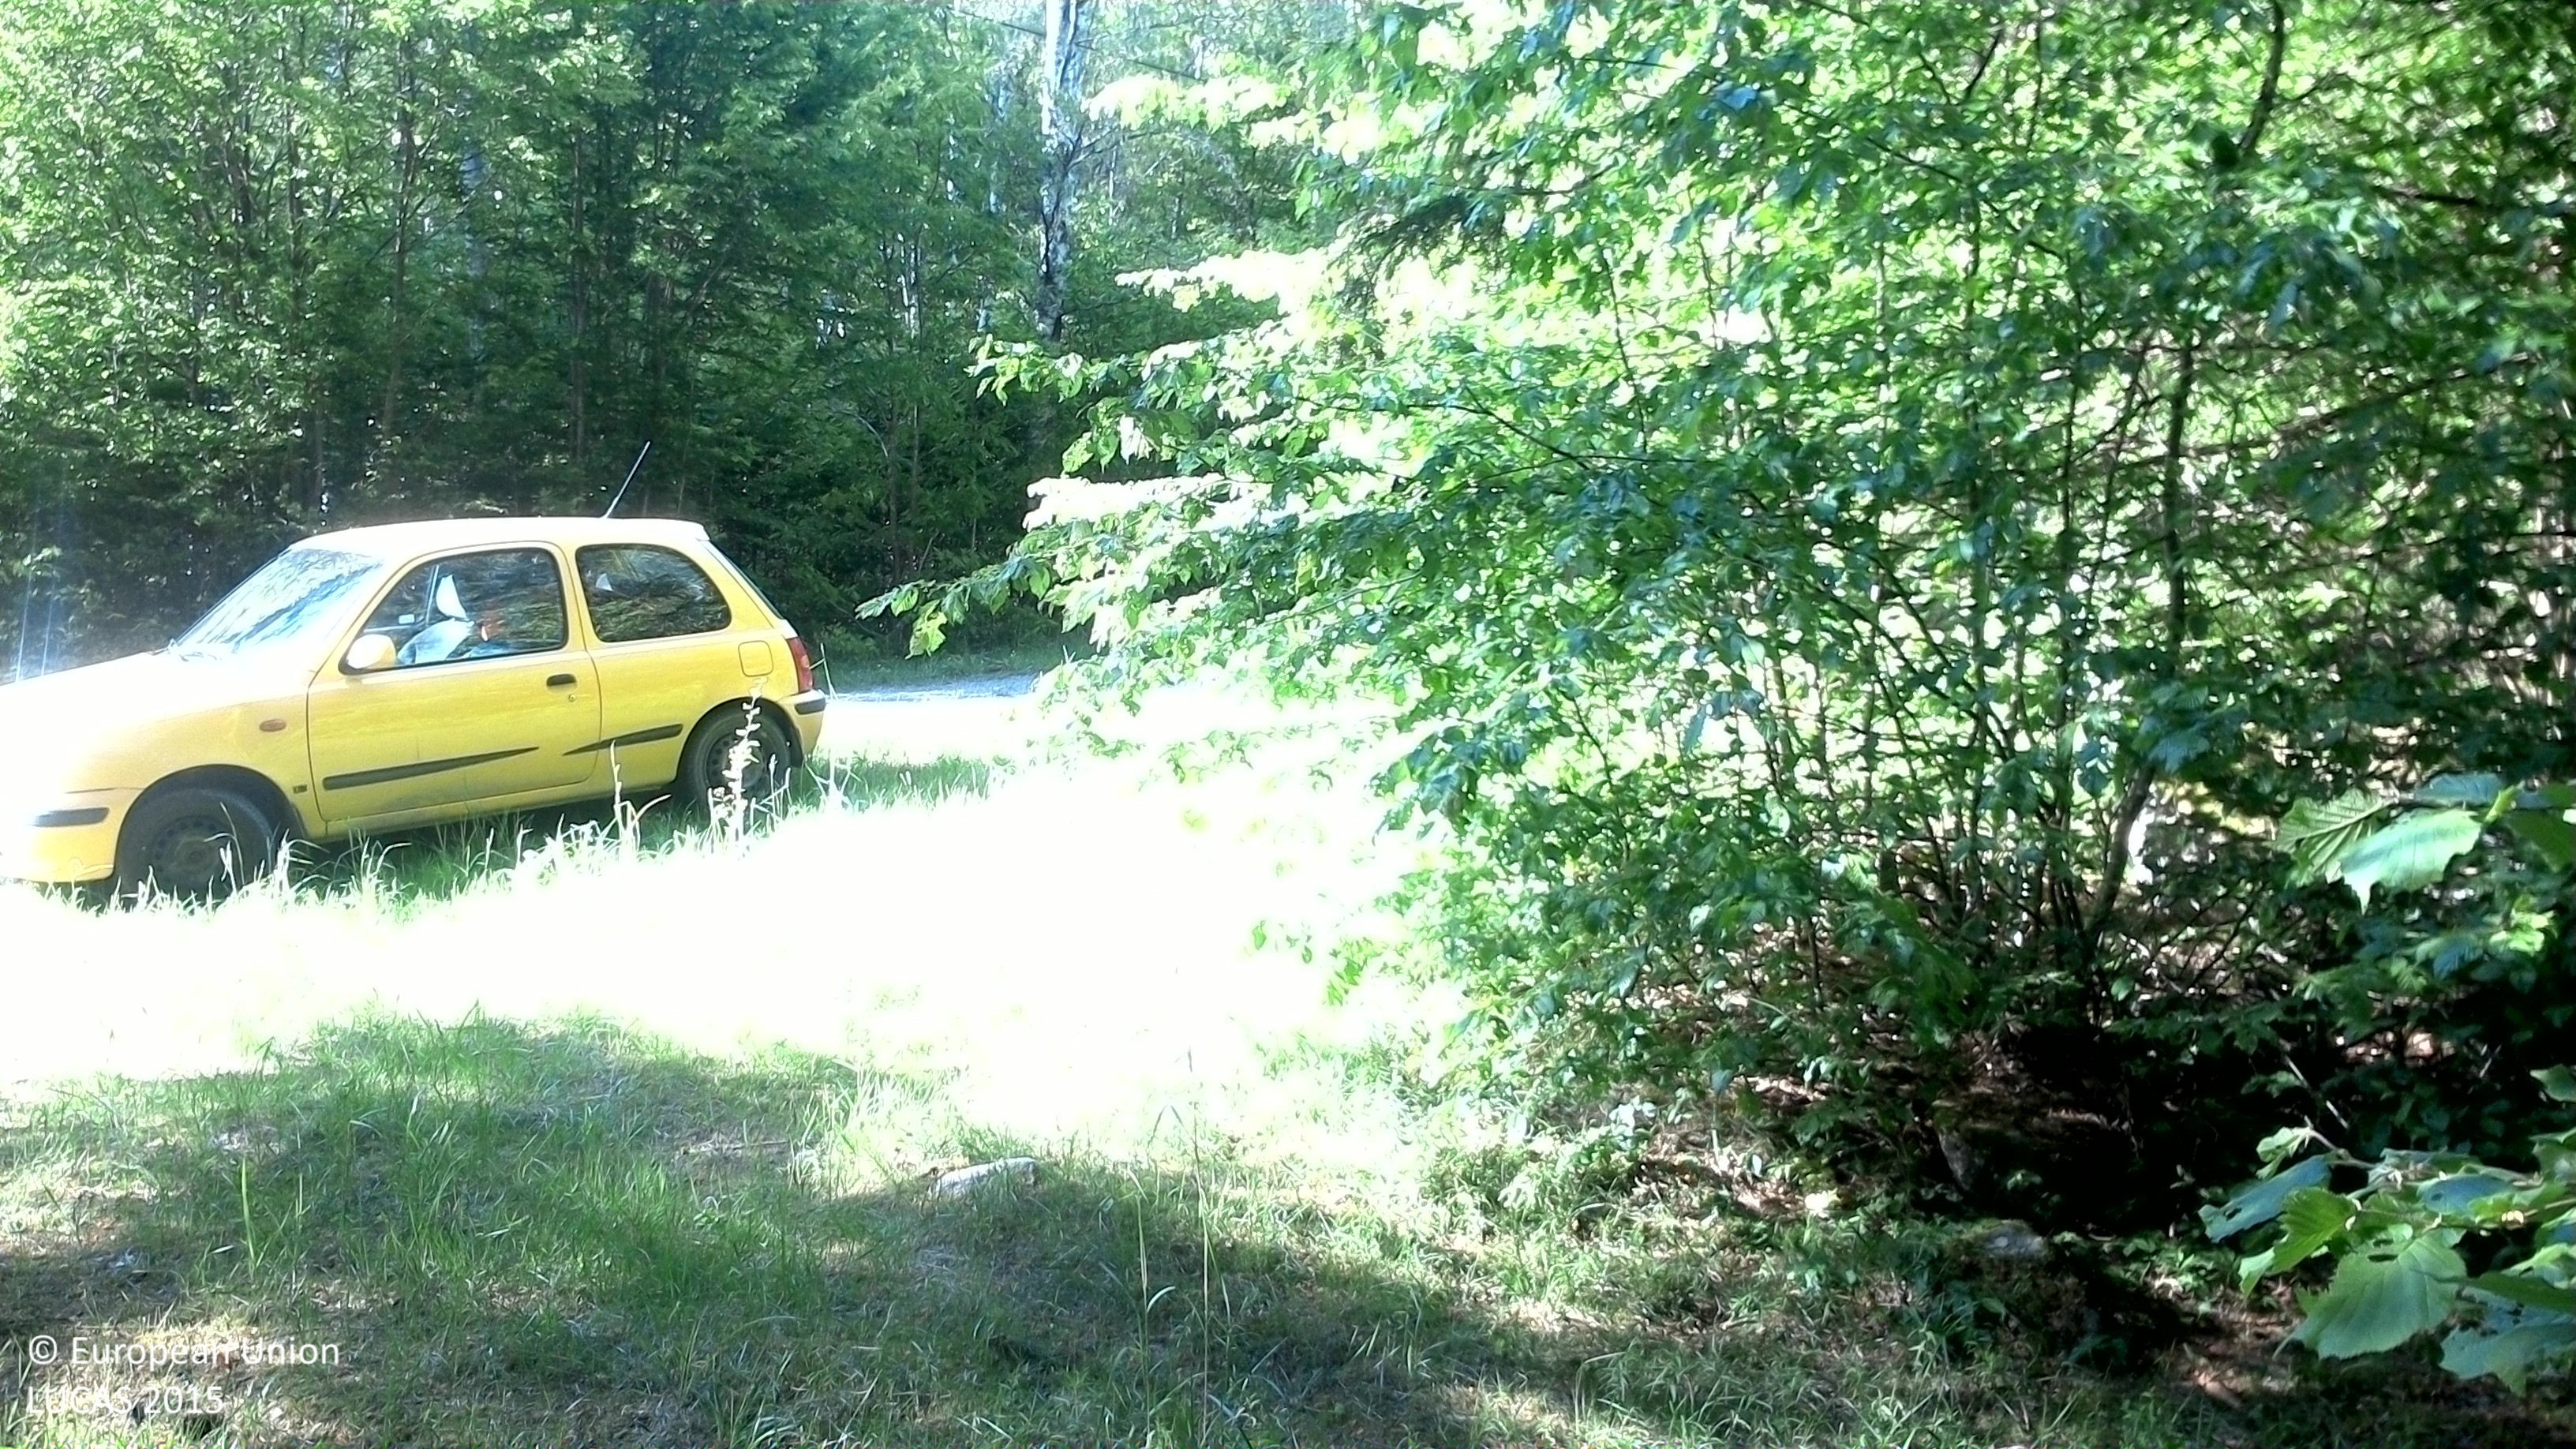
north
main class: Woodland
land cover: Spruce dominated mixed woodland
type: boreal forest
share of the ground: > 75 %
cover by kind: coniferous forest trees 60 %, broadleaved forest trees 20 %, herbaceous plants 20 %
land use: Forestry
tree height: > 5 m
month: June
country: SE
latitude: 56.5955
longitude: 15.8464
